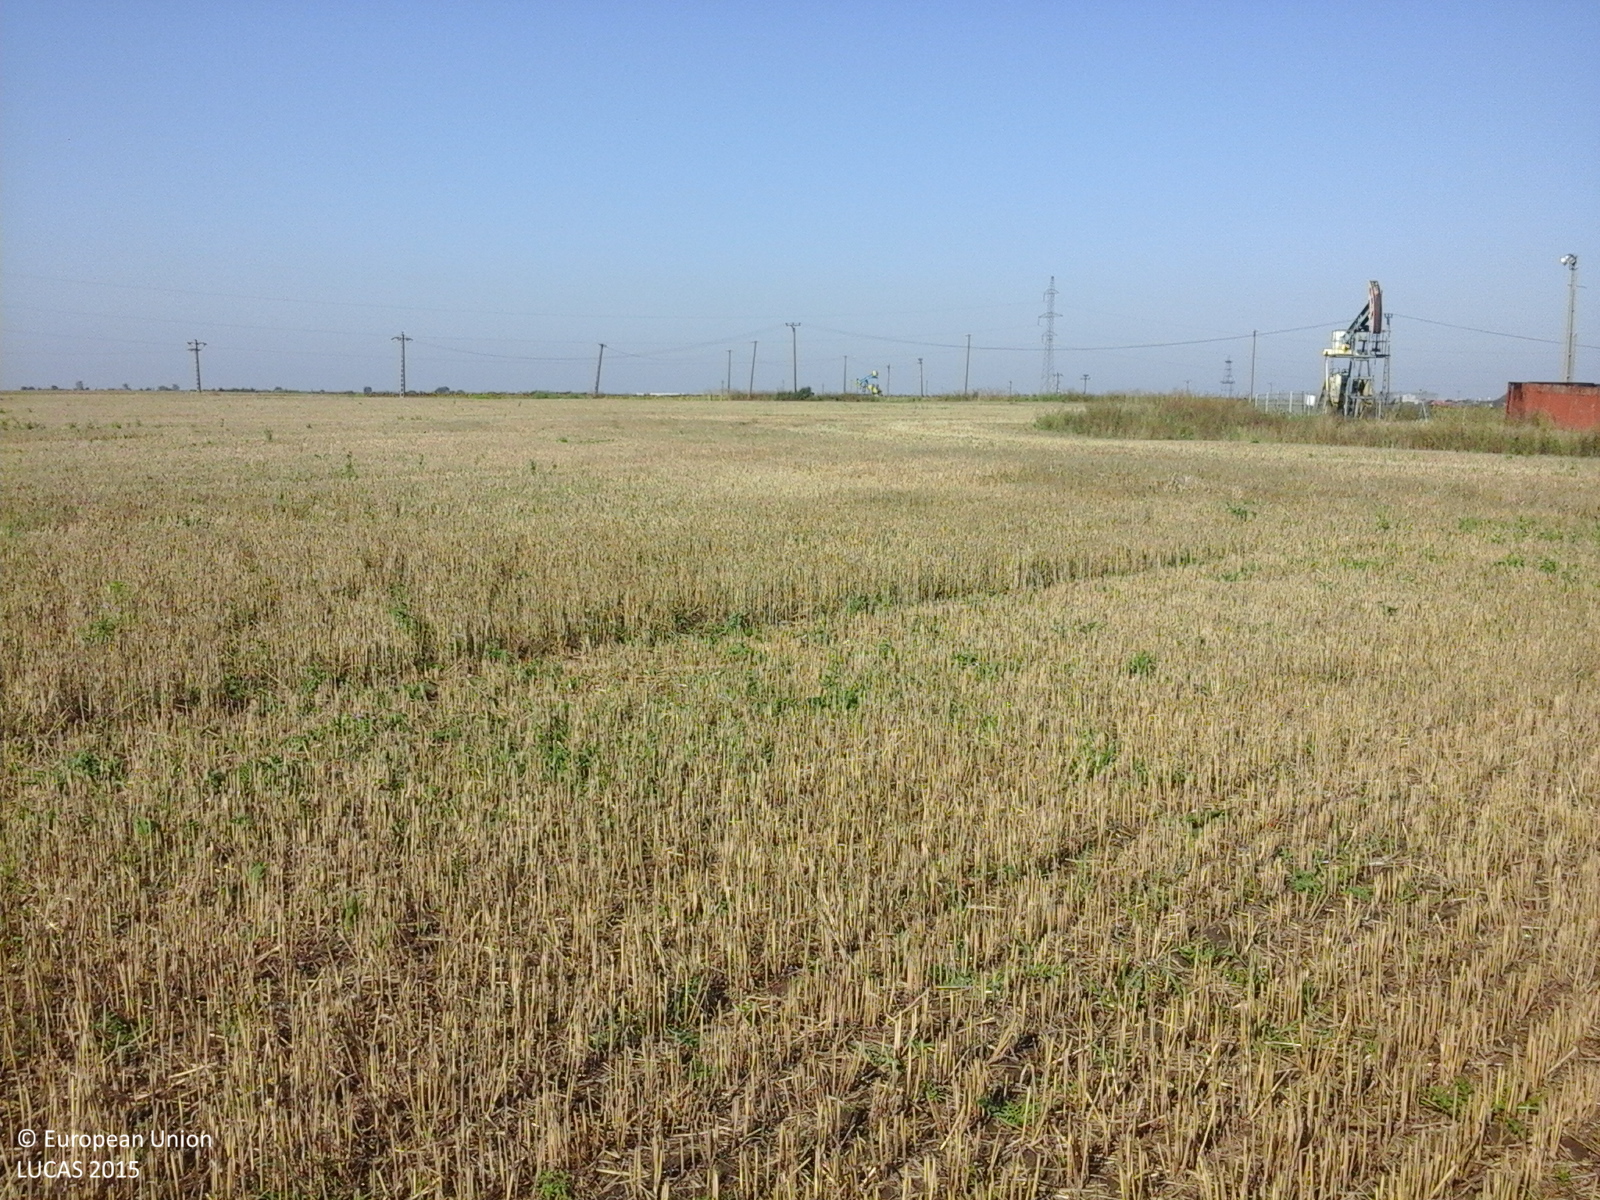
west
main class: Cropland
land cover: Common wheat
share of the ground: 25 - 50 %
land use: Agriculture (excluding fallow land and kitchen gardens)
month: August
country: RO
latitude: 45.8221
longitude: 21.1378
